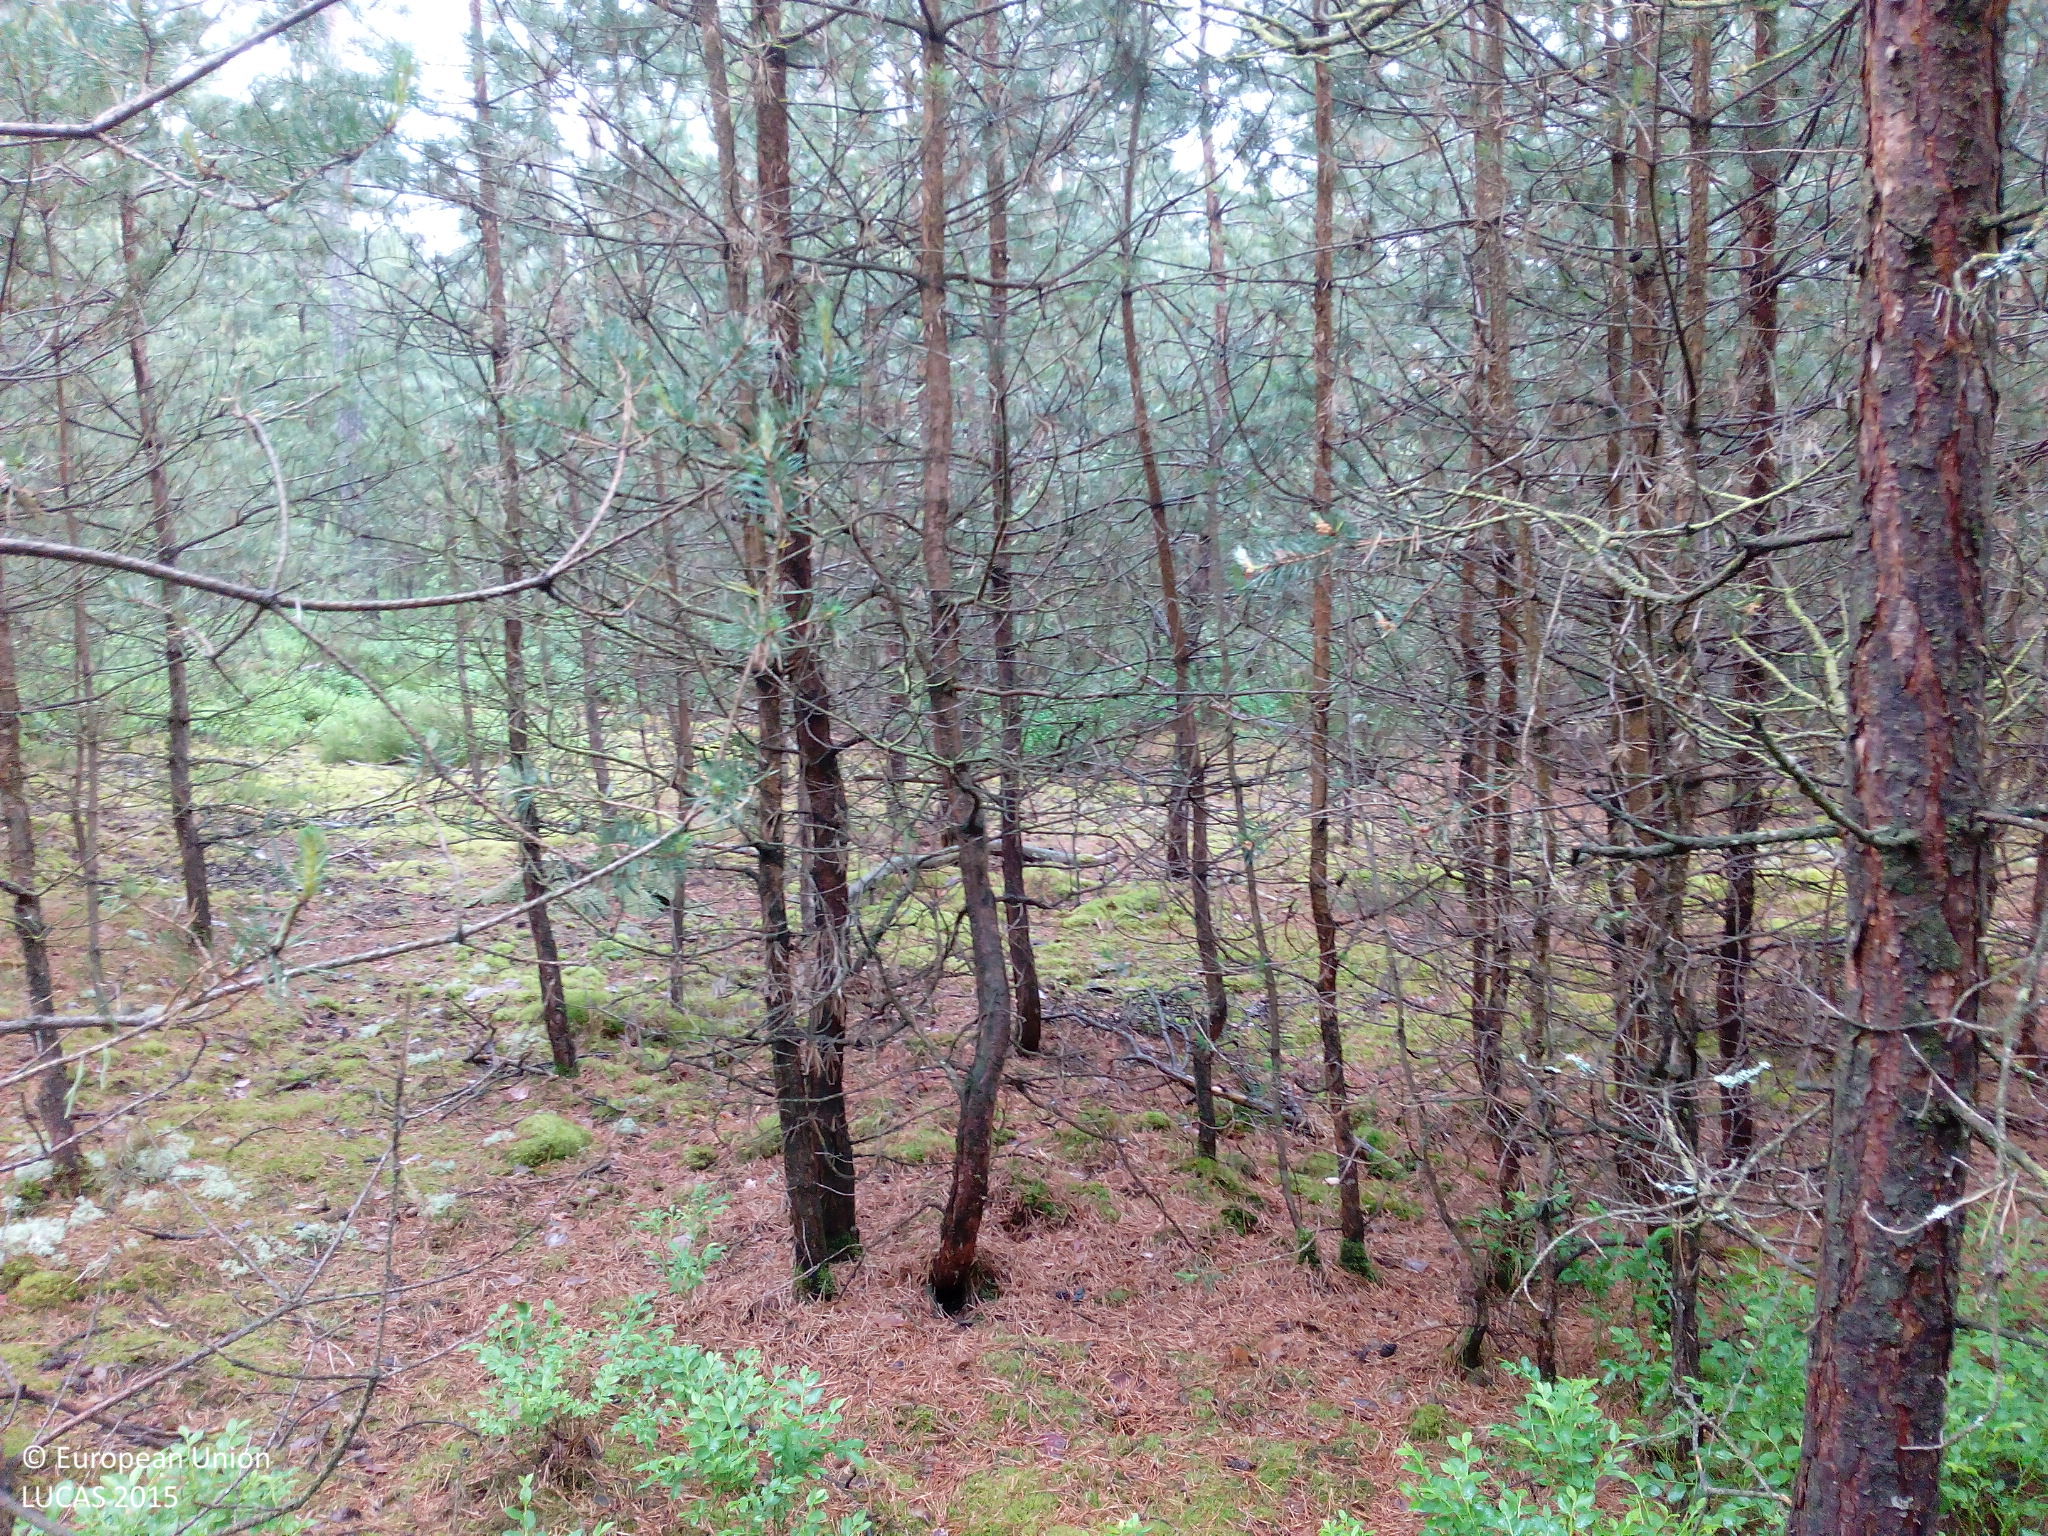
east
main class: Woodland
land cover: Pine dominated coniferous woodland
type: hemiboreal forest and nemoral coniferous forest and mixed broadleaved-coniferous forest
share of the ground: > 75 %
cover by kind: coniferous forest trees 75 %, shrubs 25 %
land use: Community services
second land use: Forestry
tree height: < 5 m
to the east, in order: Pine dominated coniferous woodland; Pine dominated mixed woodland; Pine dominated coniferous woodland
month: June
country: DE
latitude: 49.3357
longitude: 12.1876
